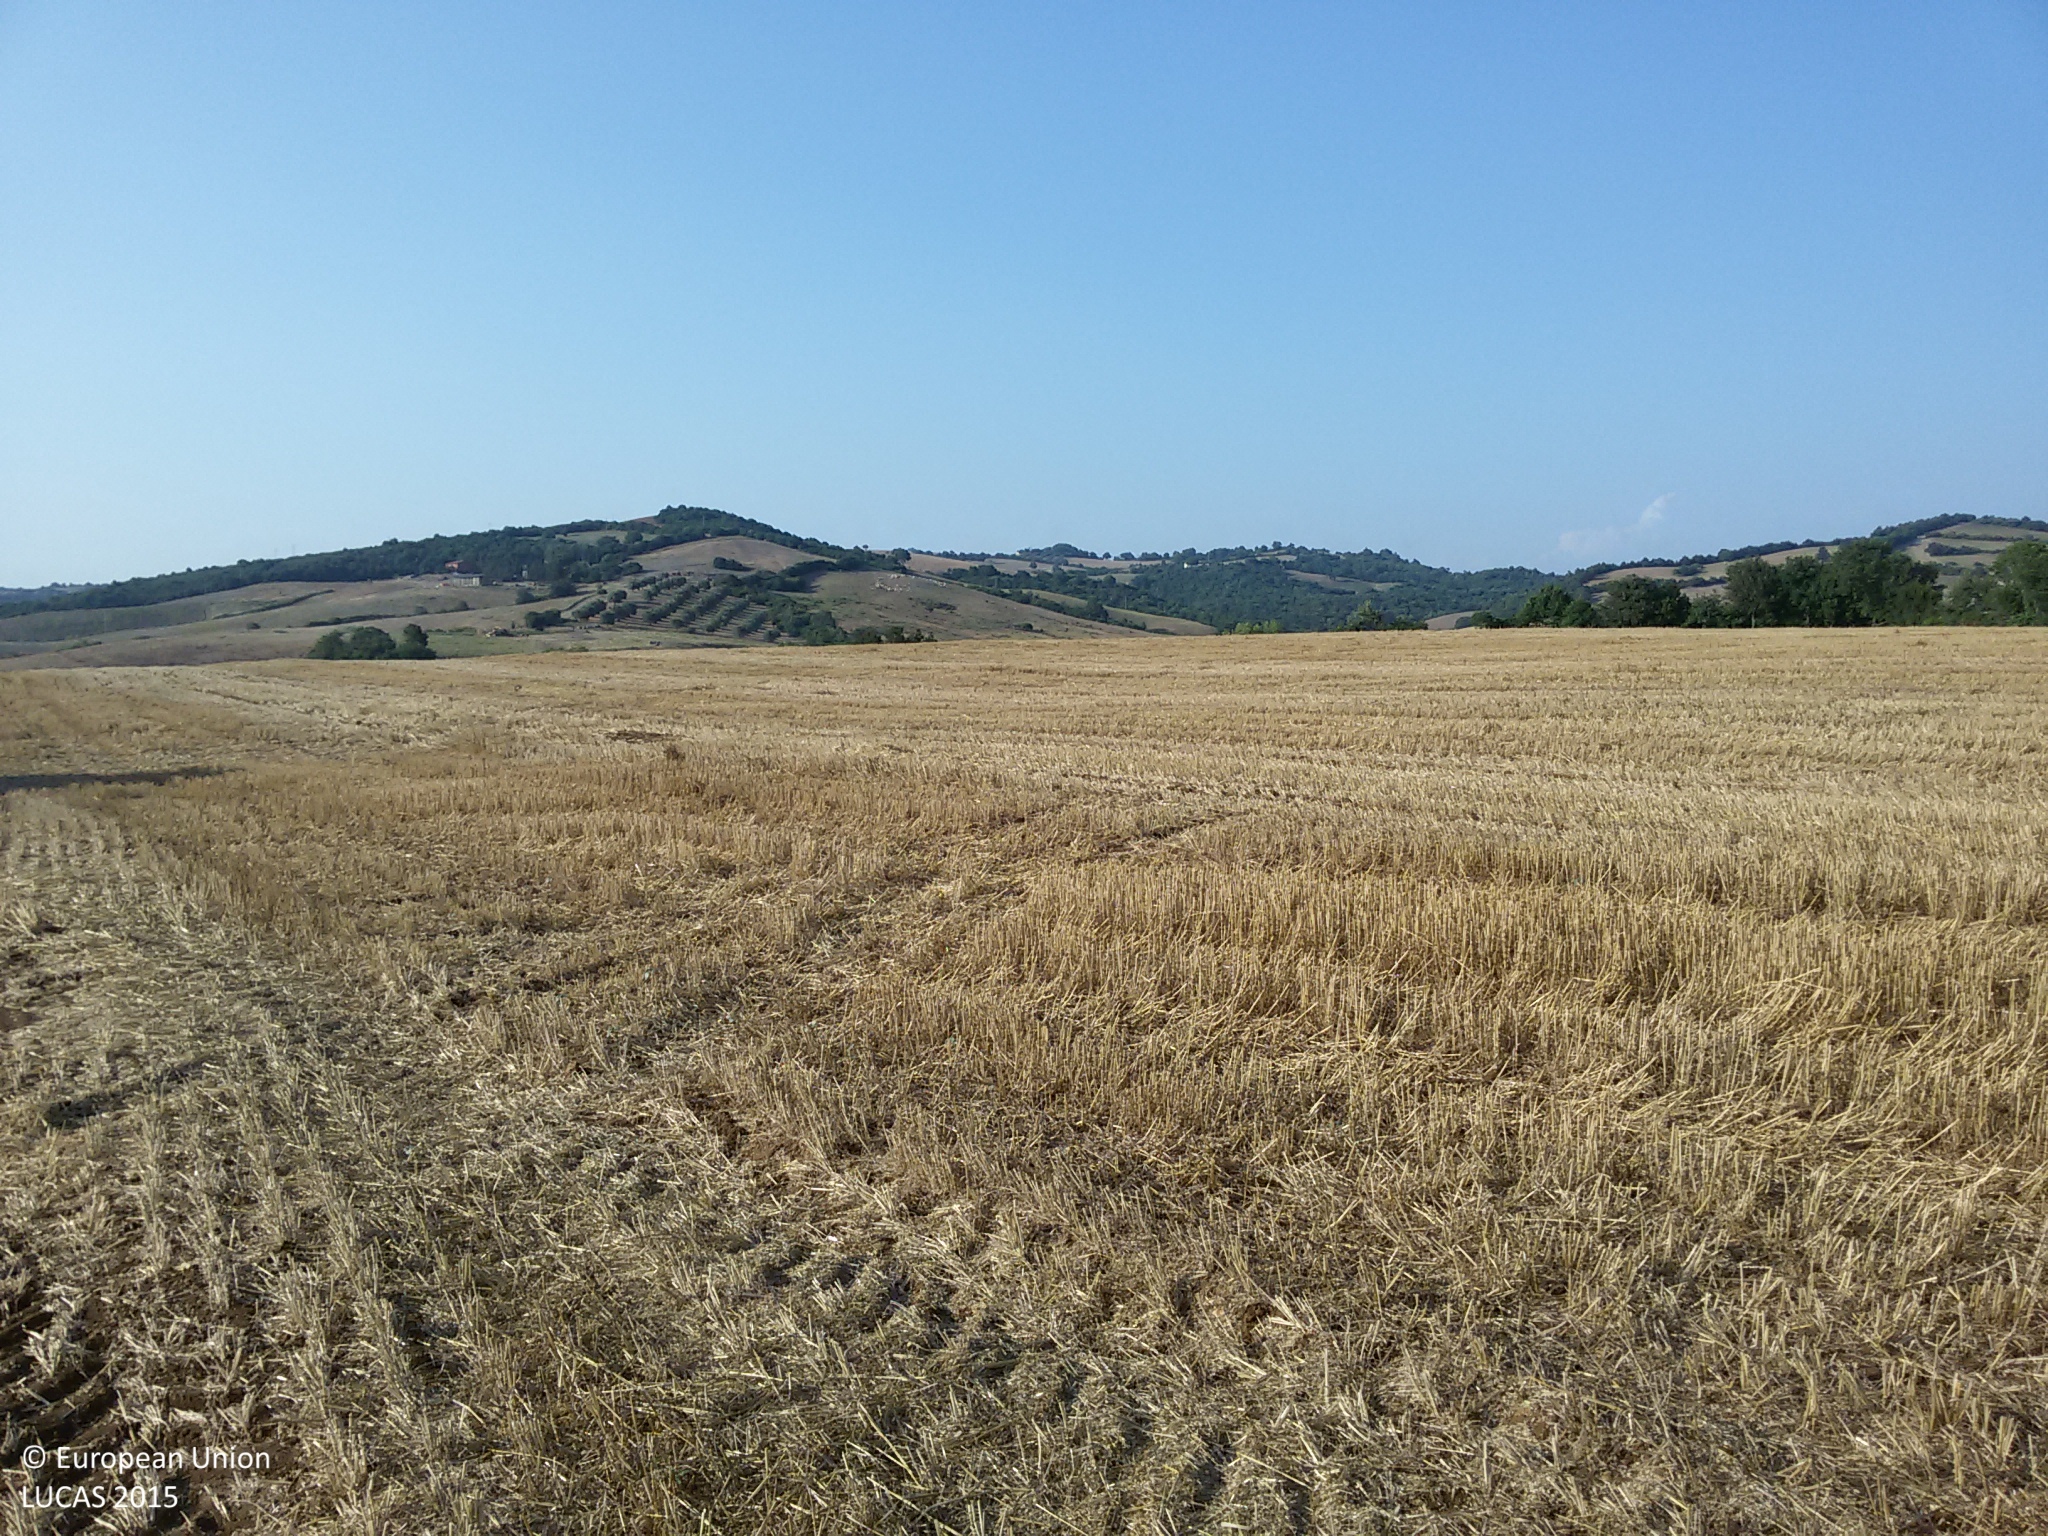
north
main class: Cropland
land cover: Durum wheat
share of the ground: > 75 %
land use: Agriculture (excluding fallow land and kitchen gardens)
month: July
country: IT
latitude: 42.5531
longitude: 11.4687
